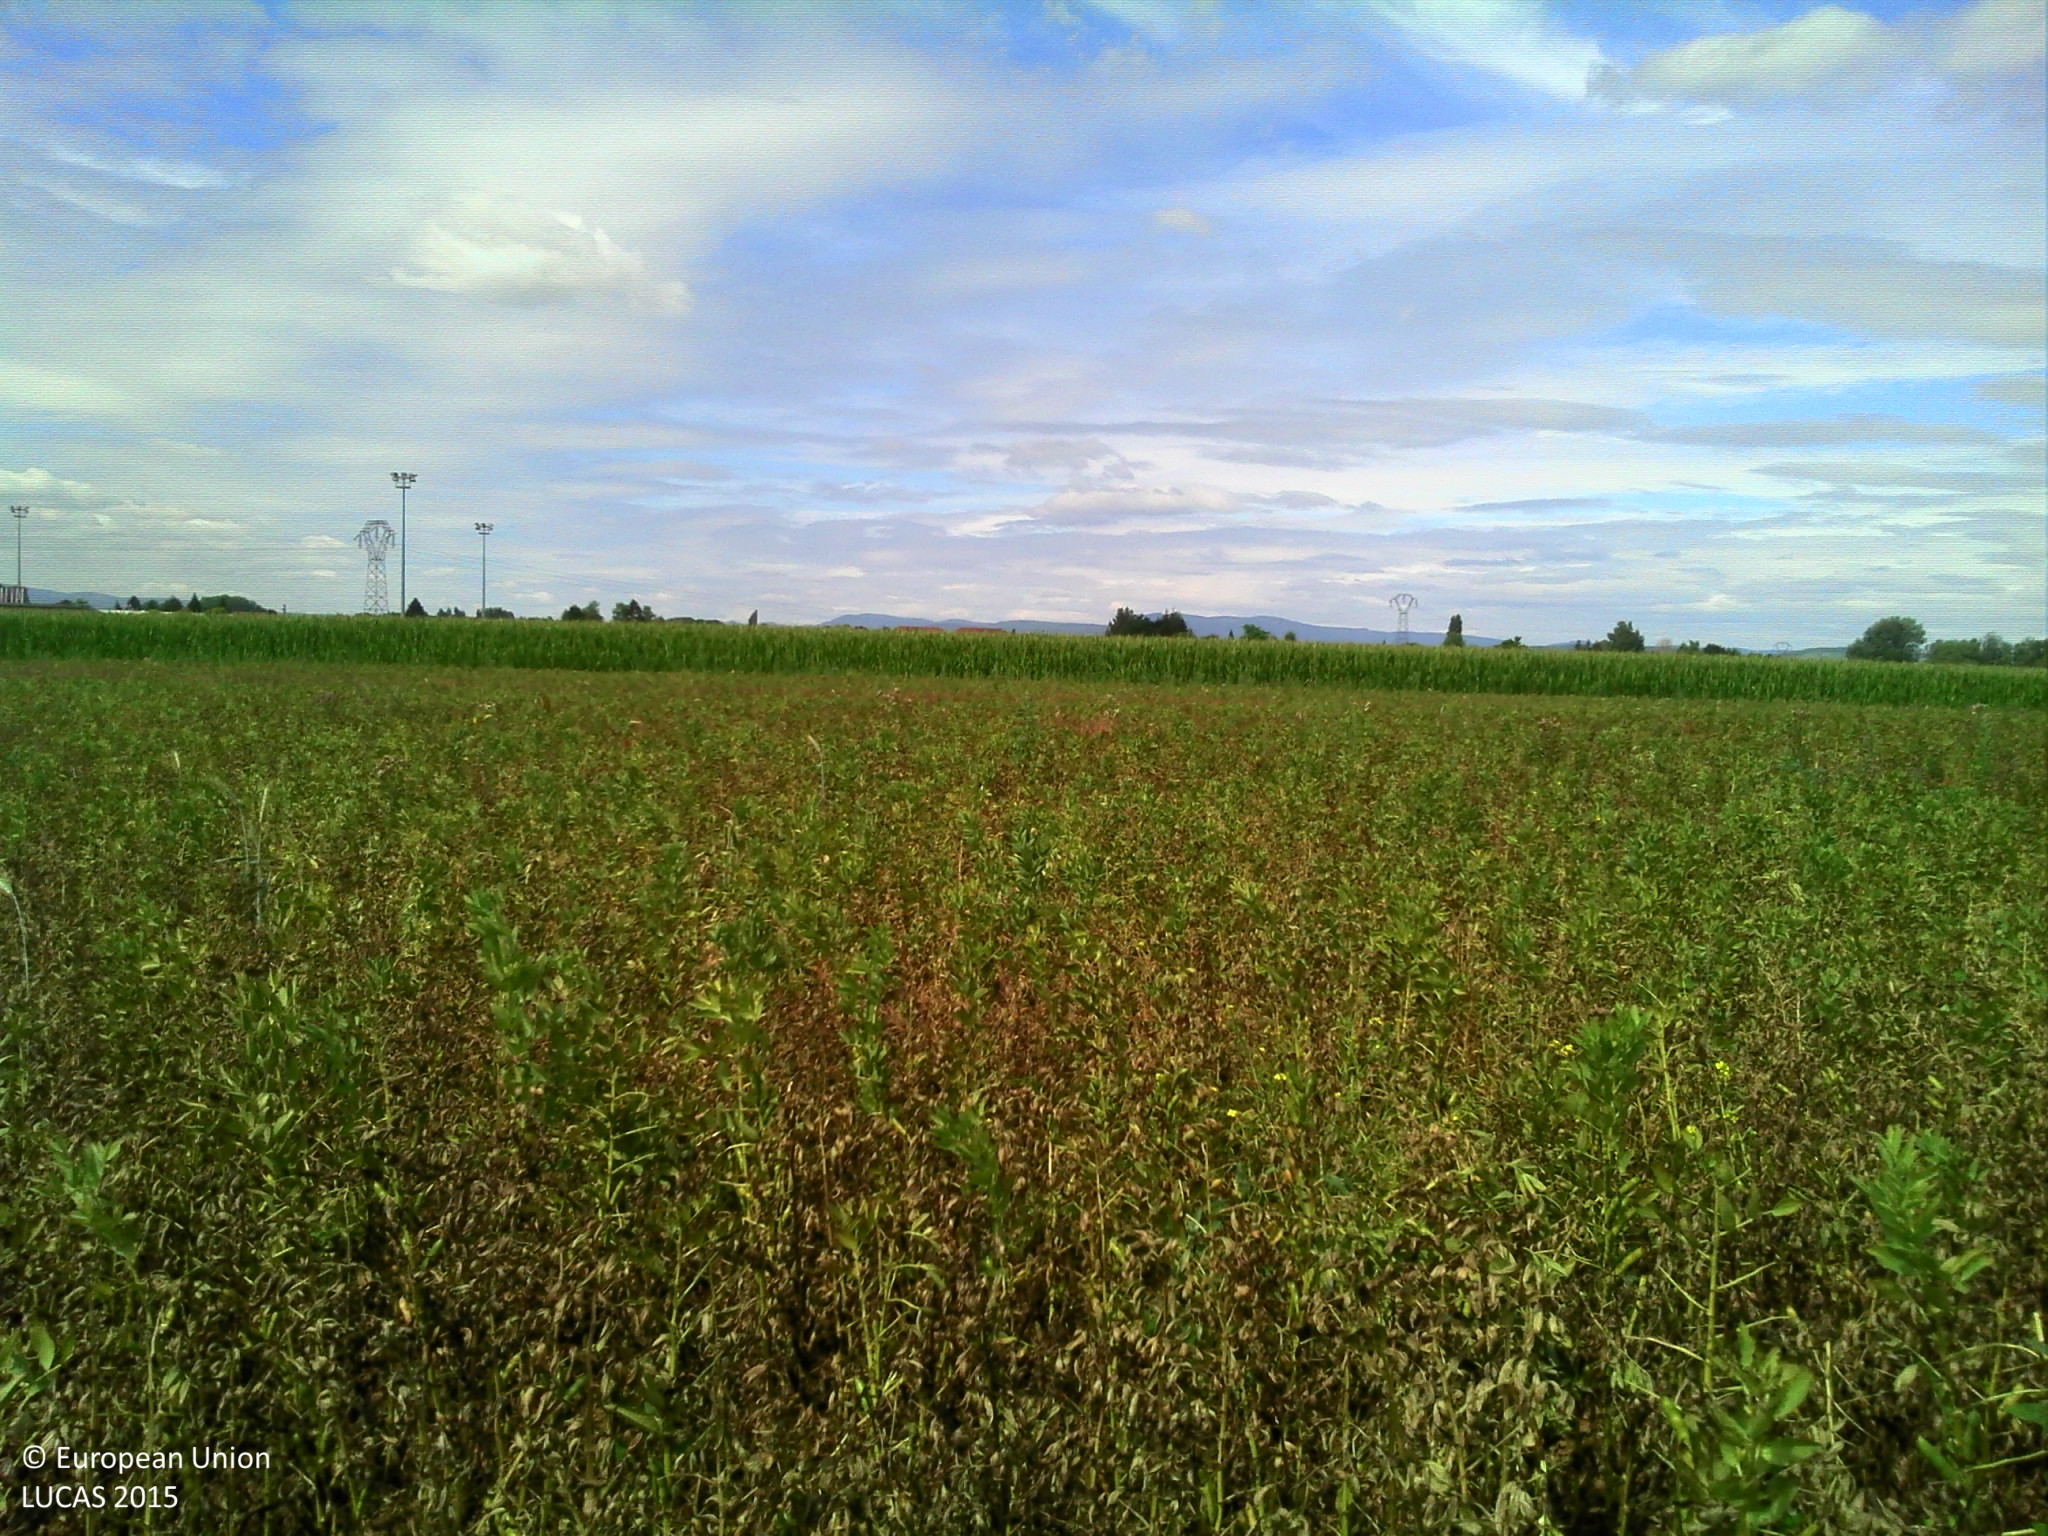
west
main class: Cropland
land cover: Soya
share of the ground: > 75 %
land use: Agriculture (excluding fallow land and kitchen gardens)
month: July
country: FR
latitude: 48.6115
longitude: 7.6001
